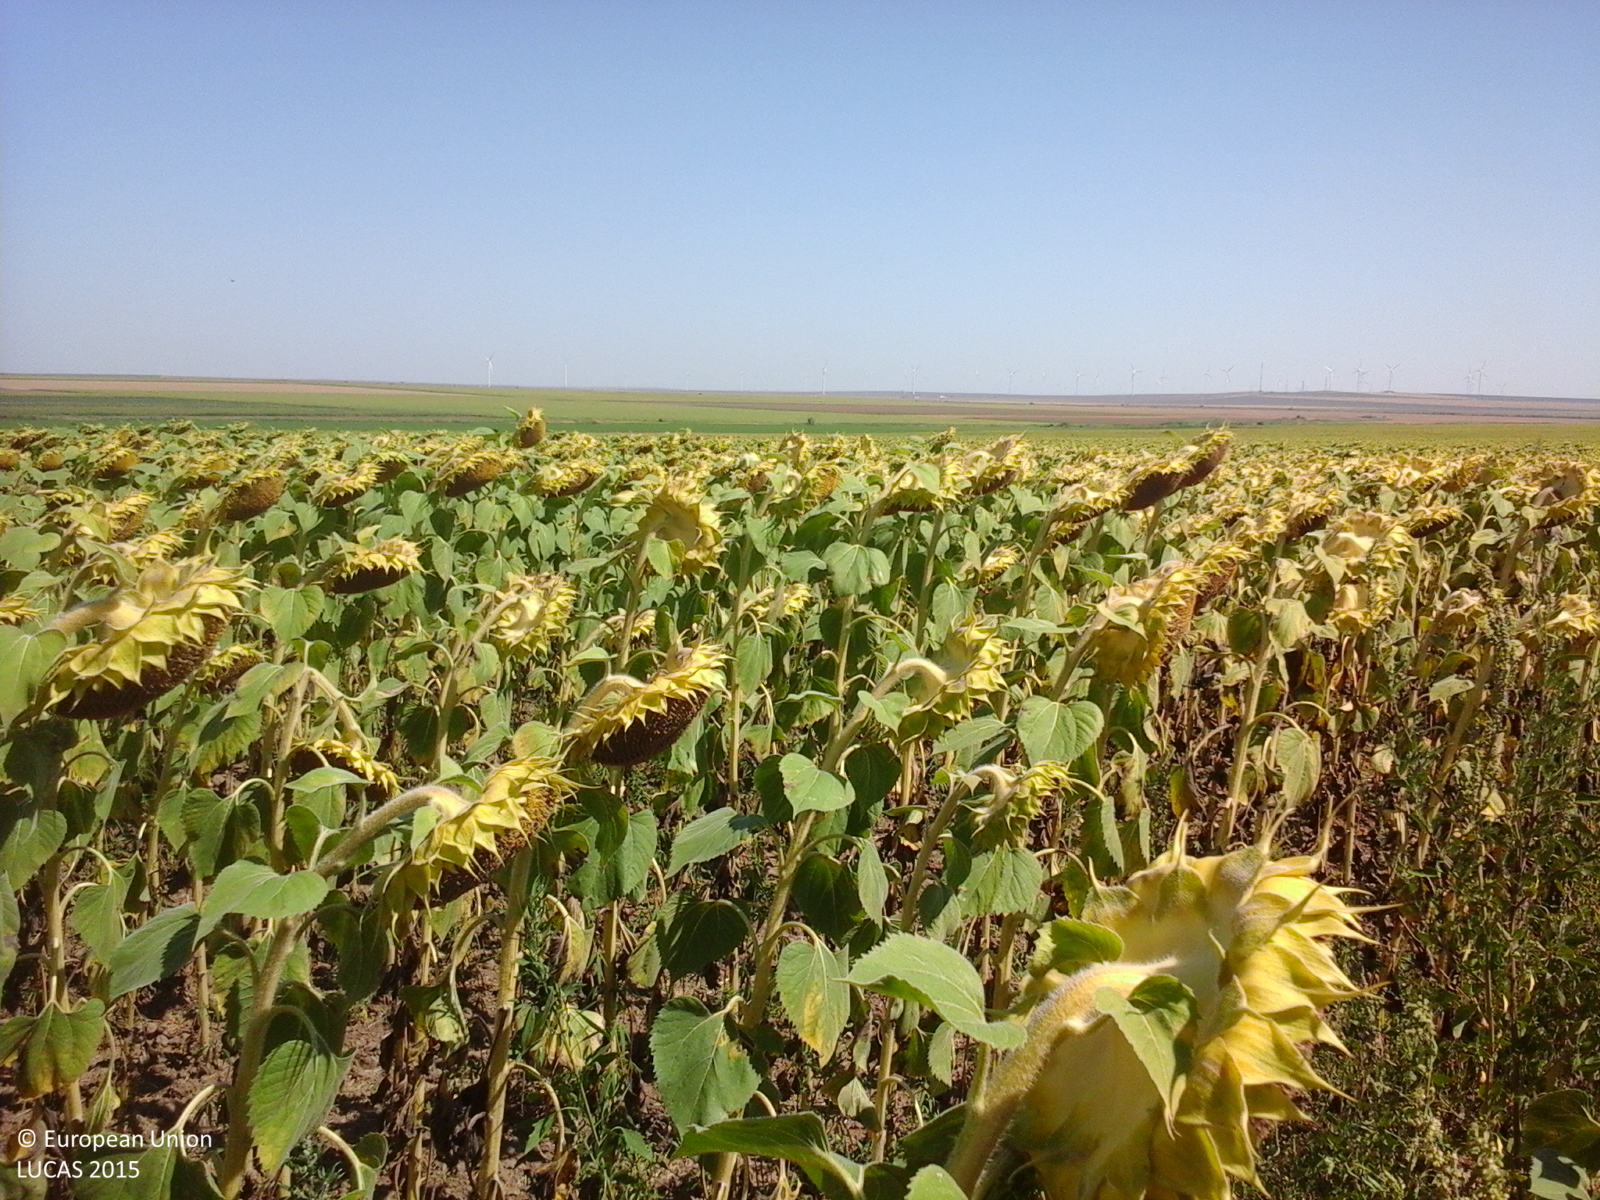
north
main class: Cropland
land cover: Sunflower
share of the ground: > 75 %
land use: Agriculture (excluding fallow land and kitchen gardens)
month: August
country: RO
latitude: 44.4286
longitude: 28.2667
